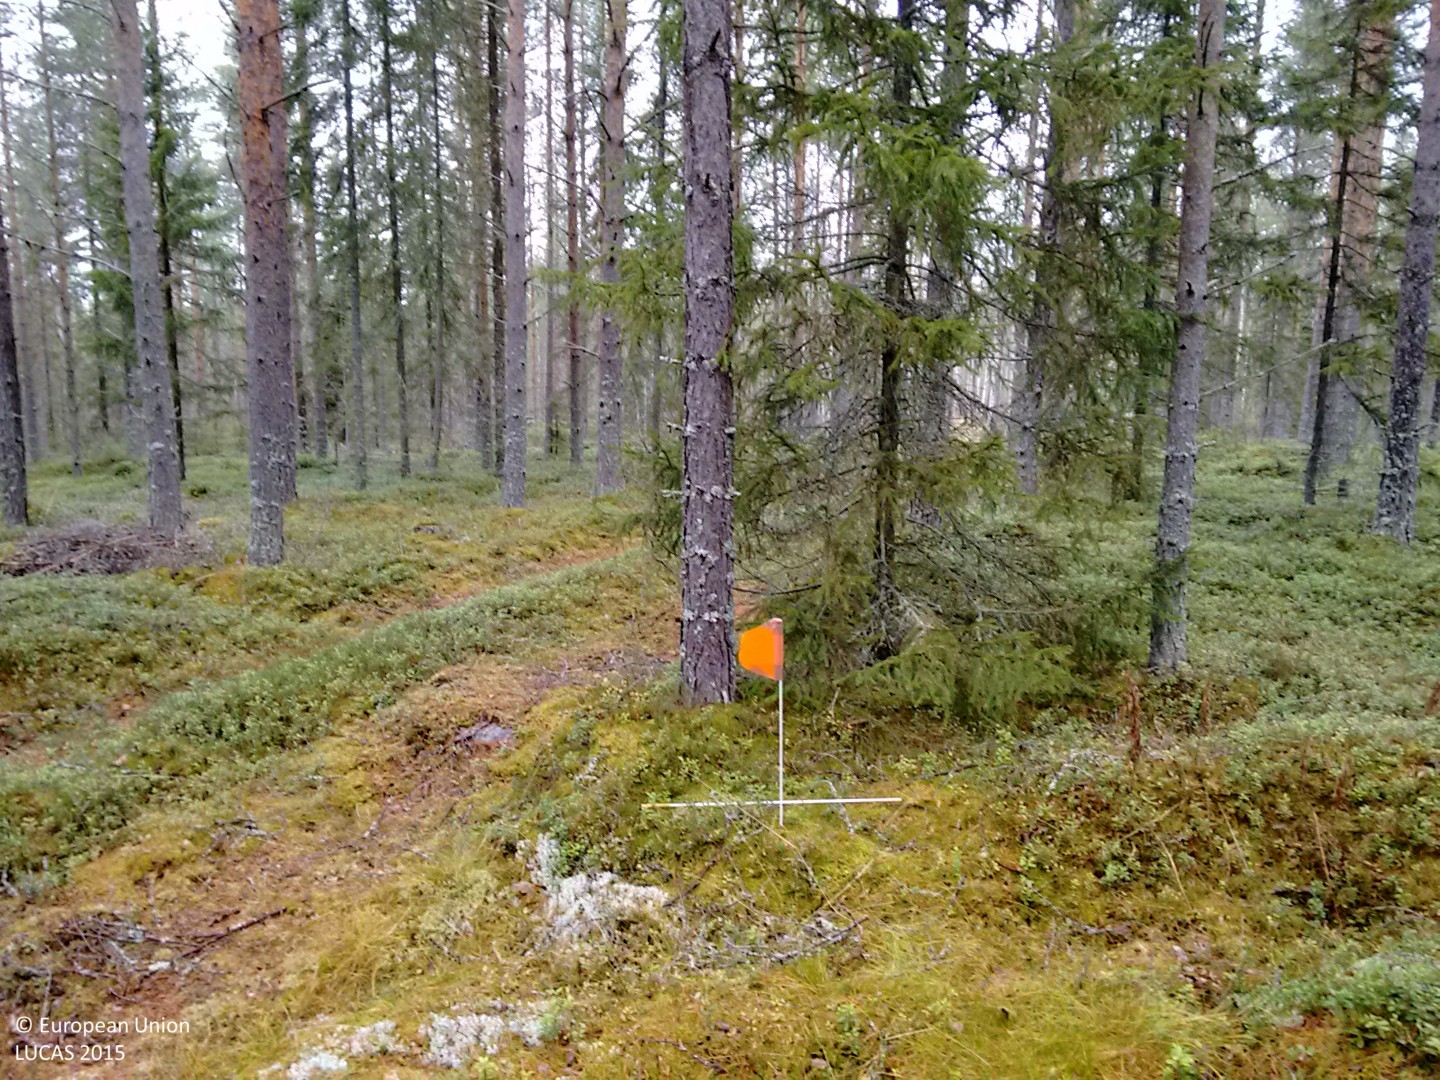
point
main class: Woodland
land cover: Pine dominated coniferous woodland
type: boreal forest
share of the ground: 50 - 75 %
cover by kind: coniferous forest trees 70 %, shrubs 20 %, lichens and mosses 10 %
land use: Forestry
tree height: > 5 m
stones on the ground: > 50 %
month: October
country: FI
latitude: 64.5248
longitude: 25.2325
